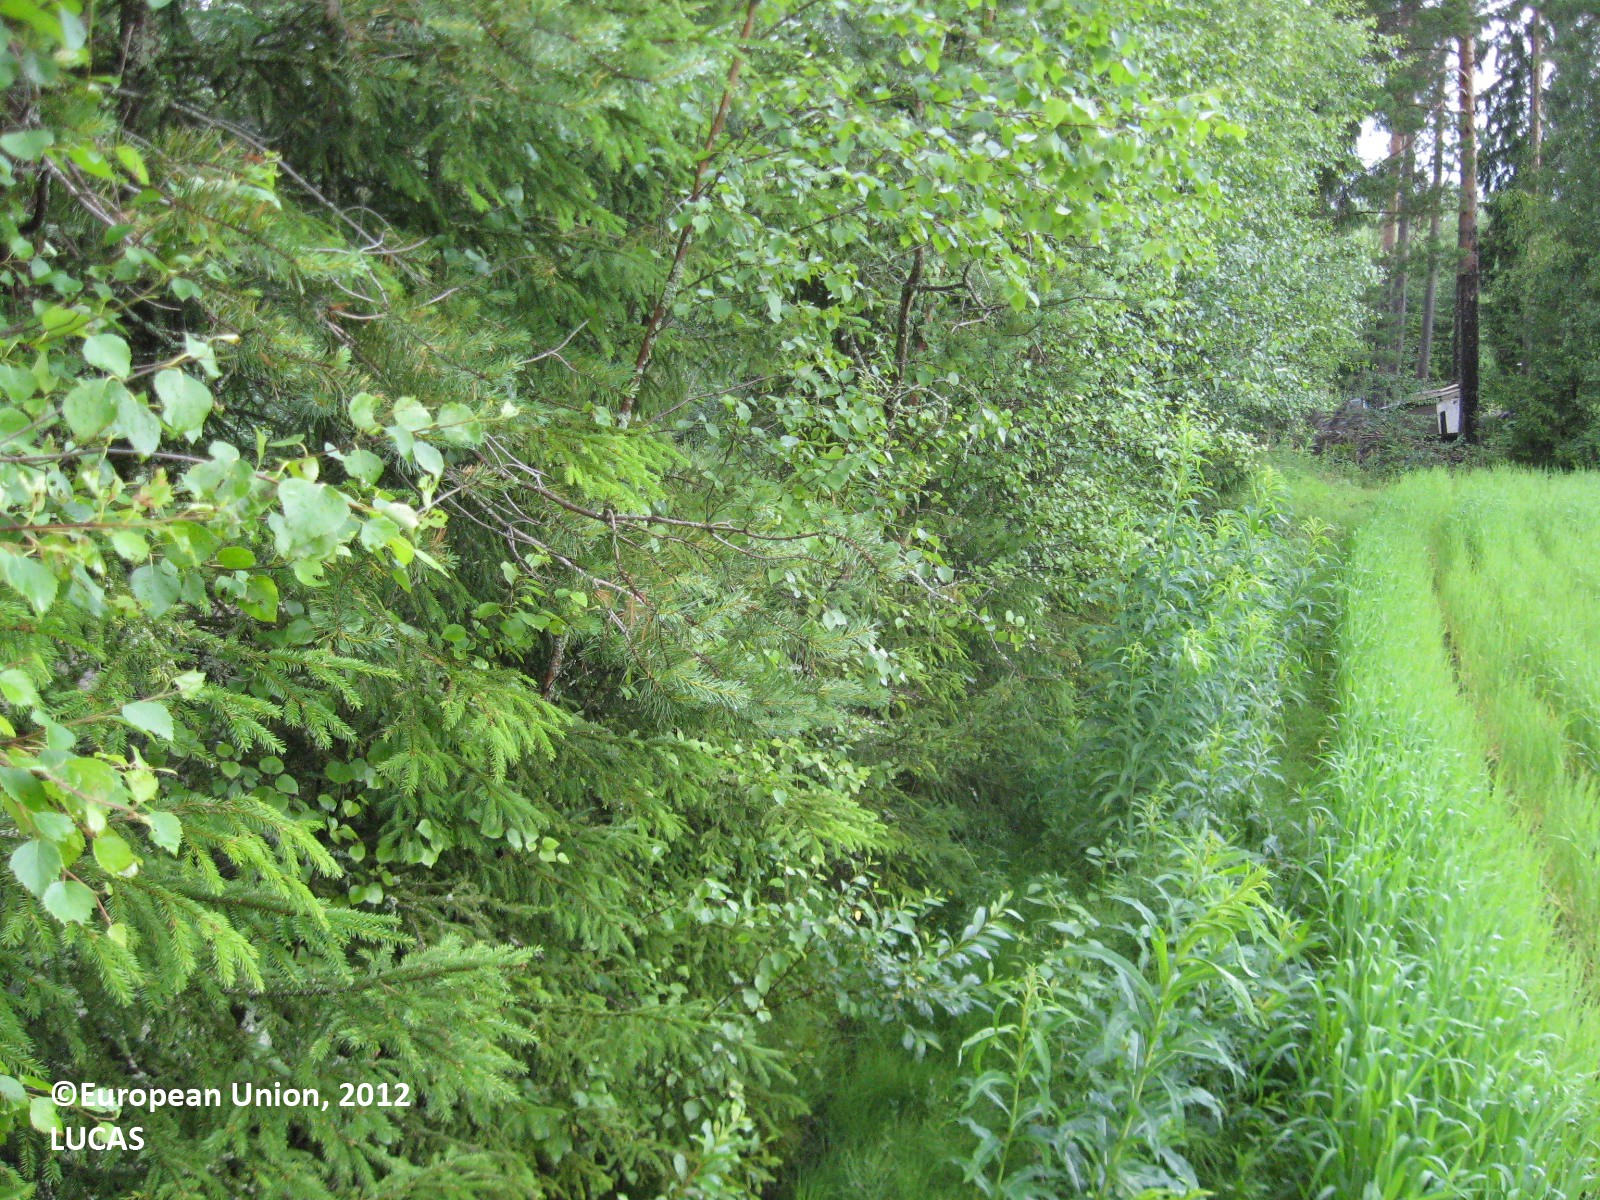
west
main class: Cropland
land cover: Barley
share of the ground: > 75 %
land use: Agriculture (excluding fallow land and kitchen gardens)
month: July
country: FI
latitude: 62.3536
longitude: 22.8309
